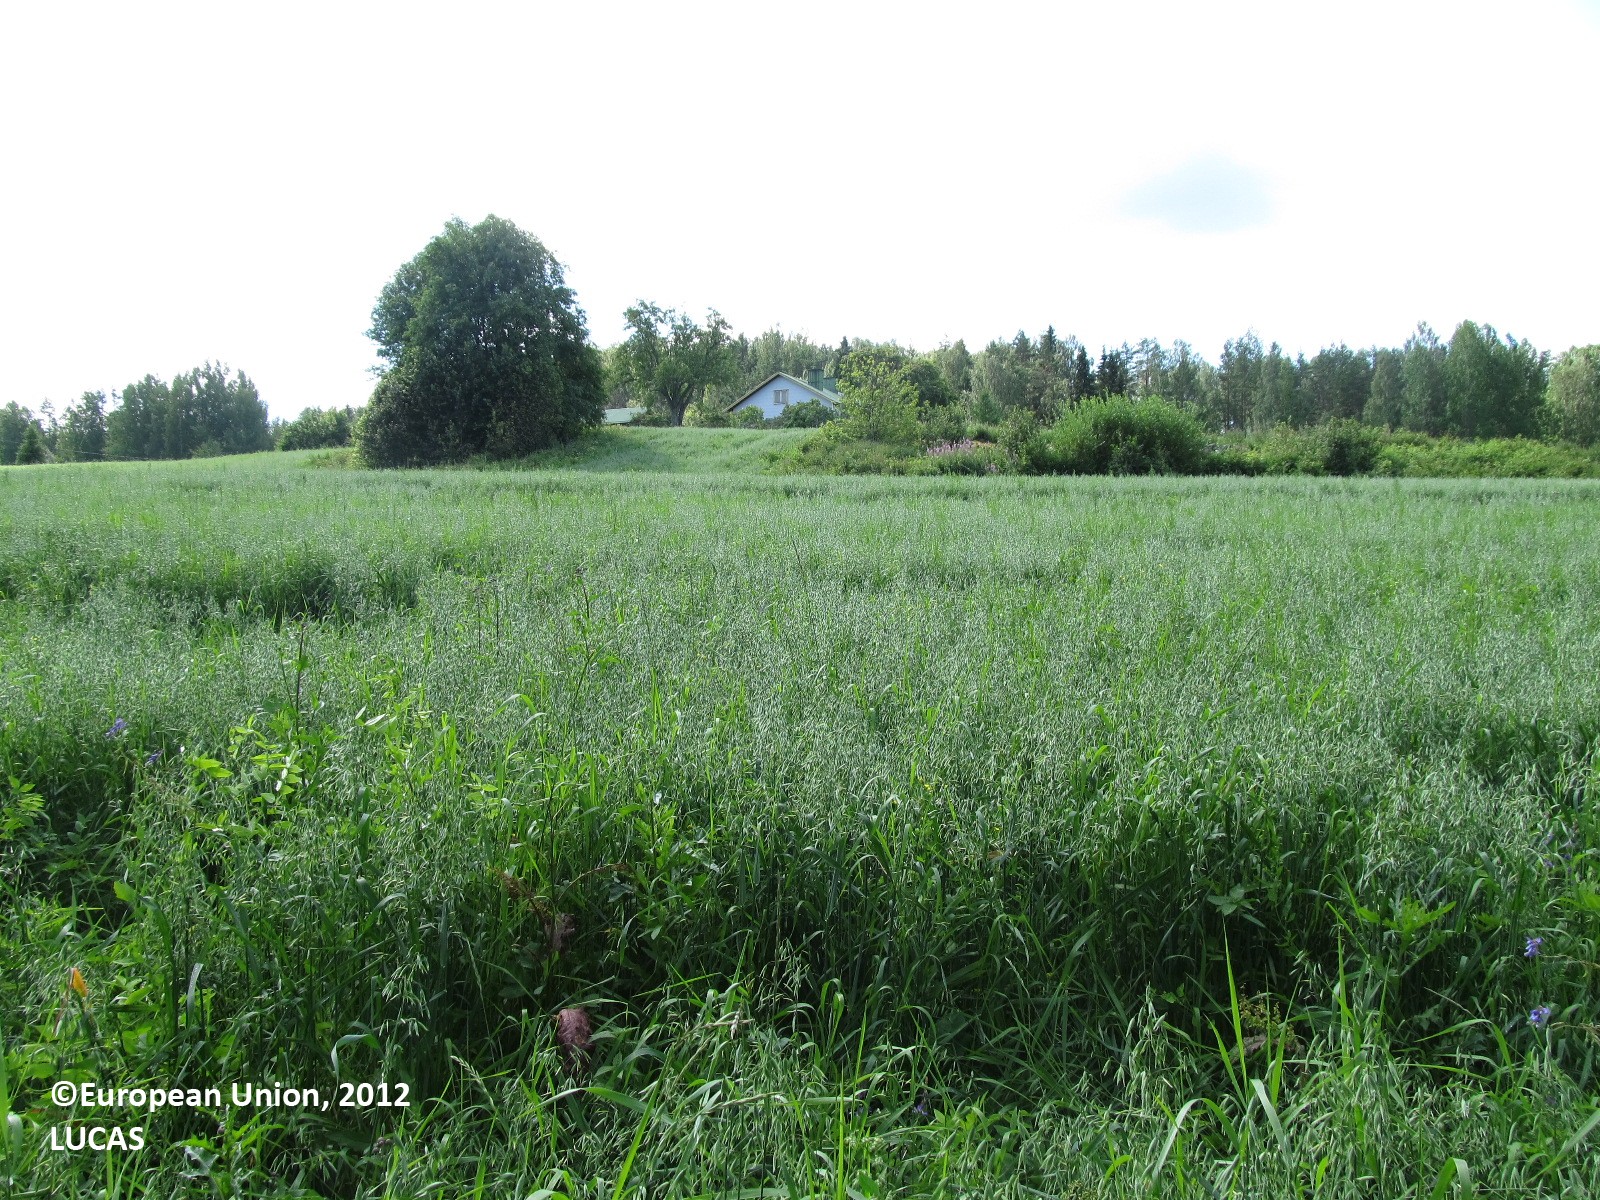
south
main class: Cropland
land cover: Oats
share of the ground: 50 - 75 %
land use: Agriculture (excluding fallow land and kitchen gardens)
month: July
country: FI
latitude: 61.9734
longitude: 28.6209
